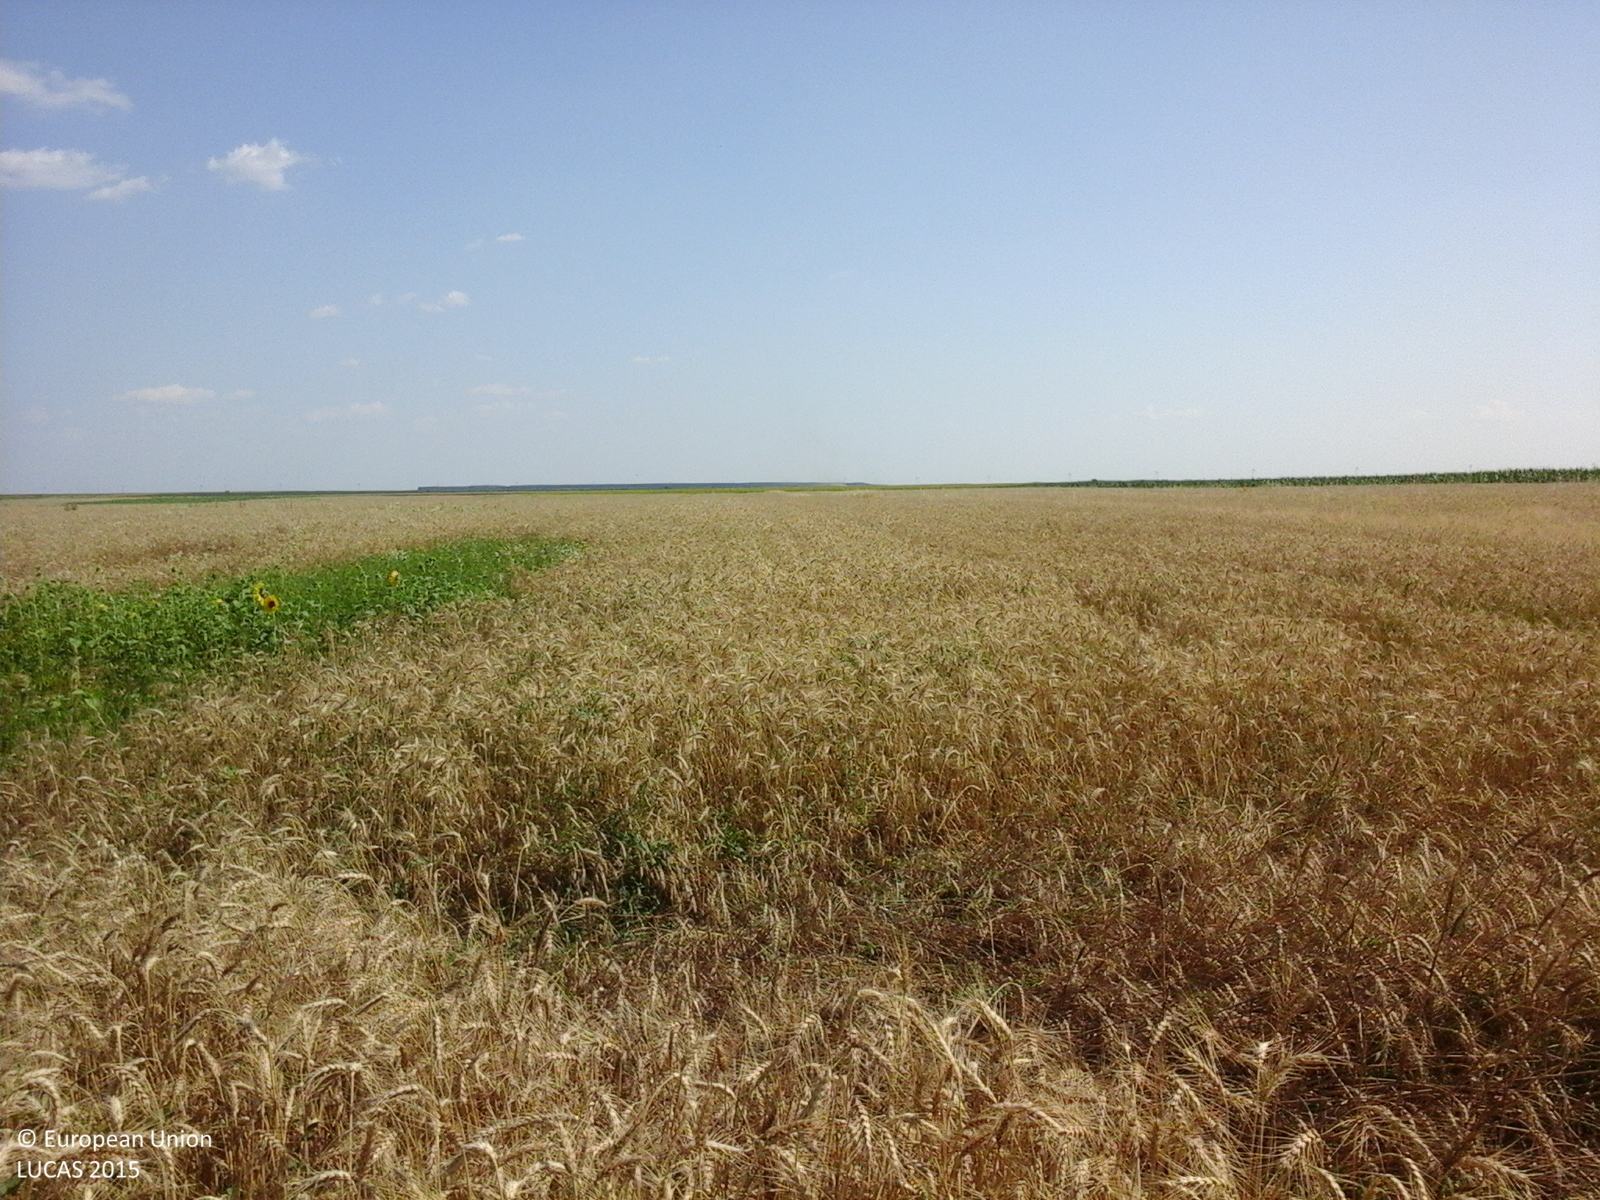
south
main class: Cropland
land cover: Common wheat
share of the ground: > 75 %
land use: Agriculture (excluding fallow land and kitchen gardens)
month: July
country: RO
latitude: 44.3707
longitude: 24.6168
